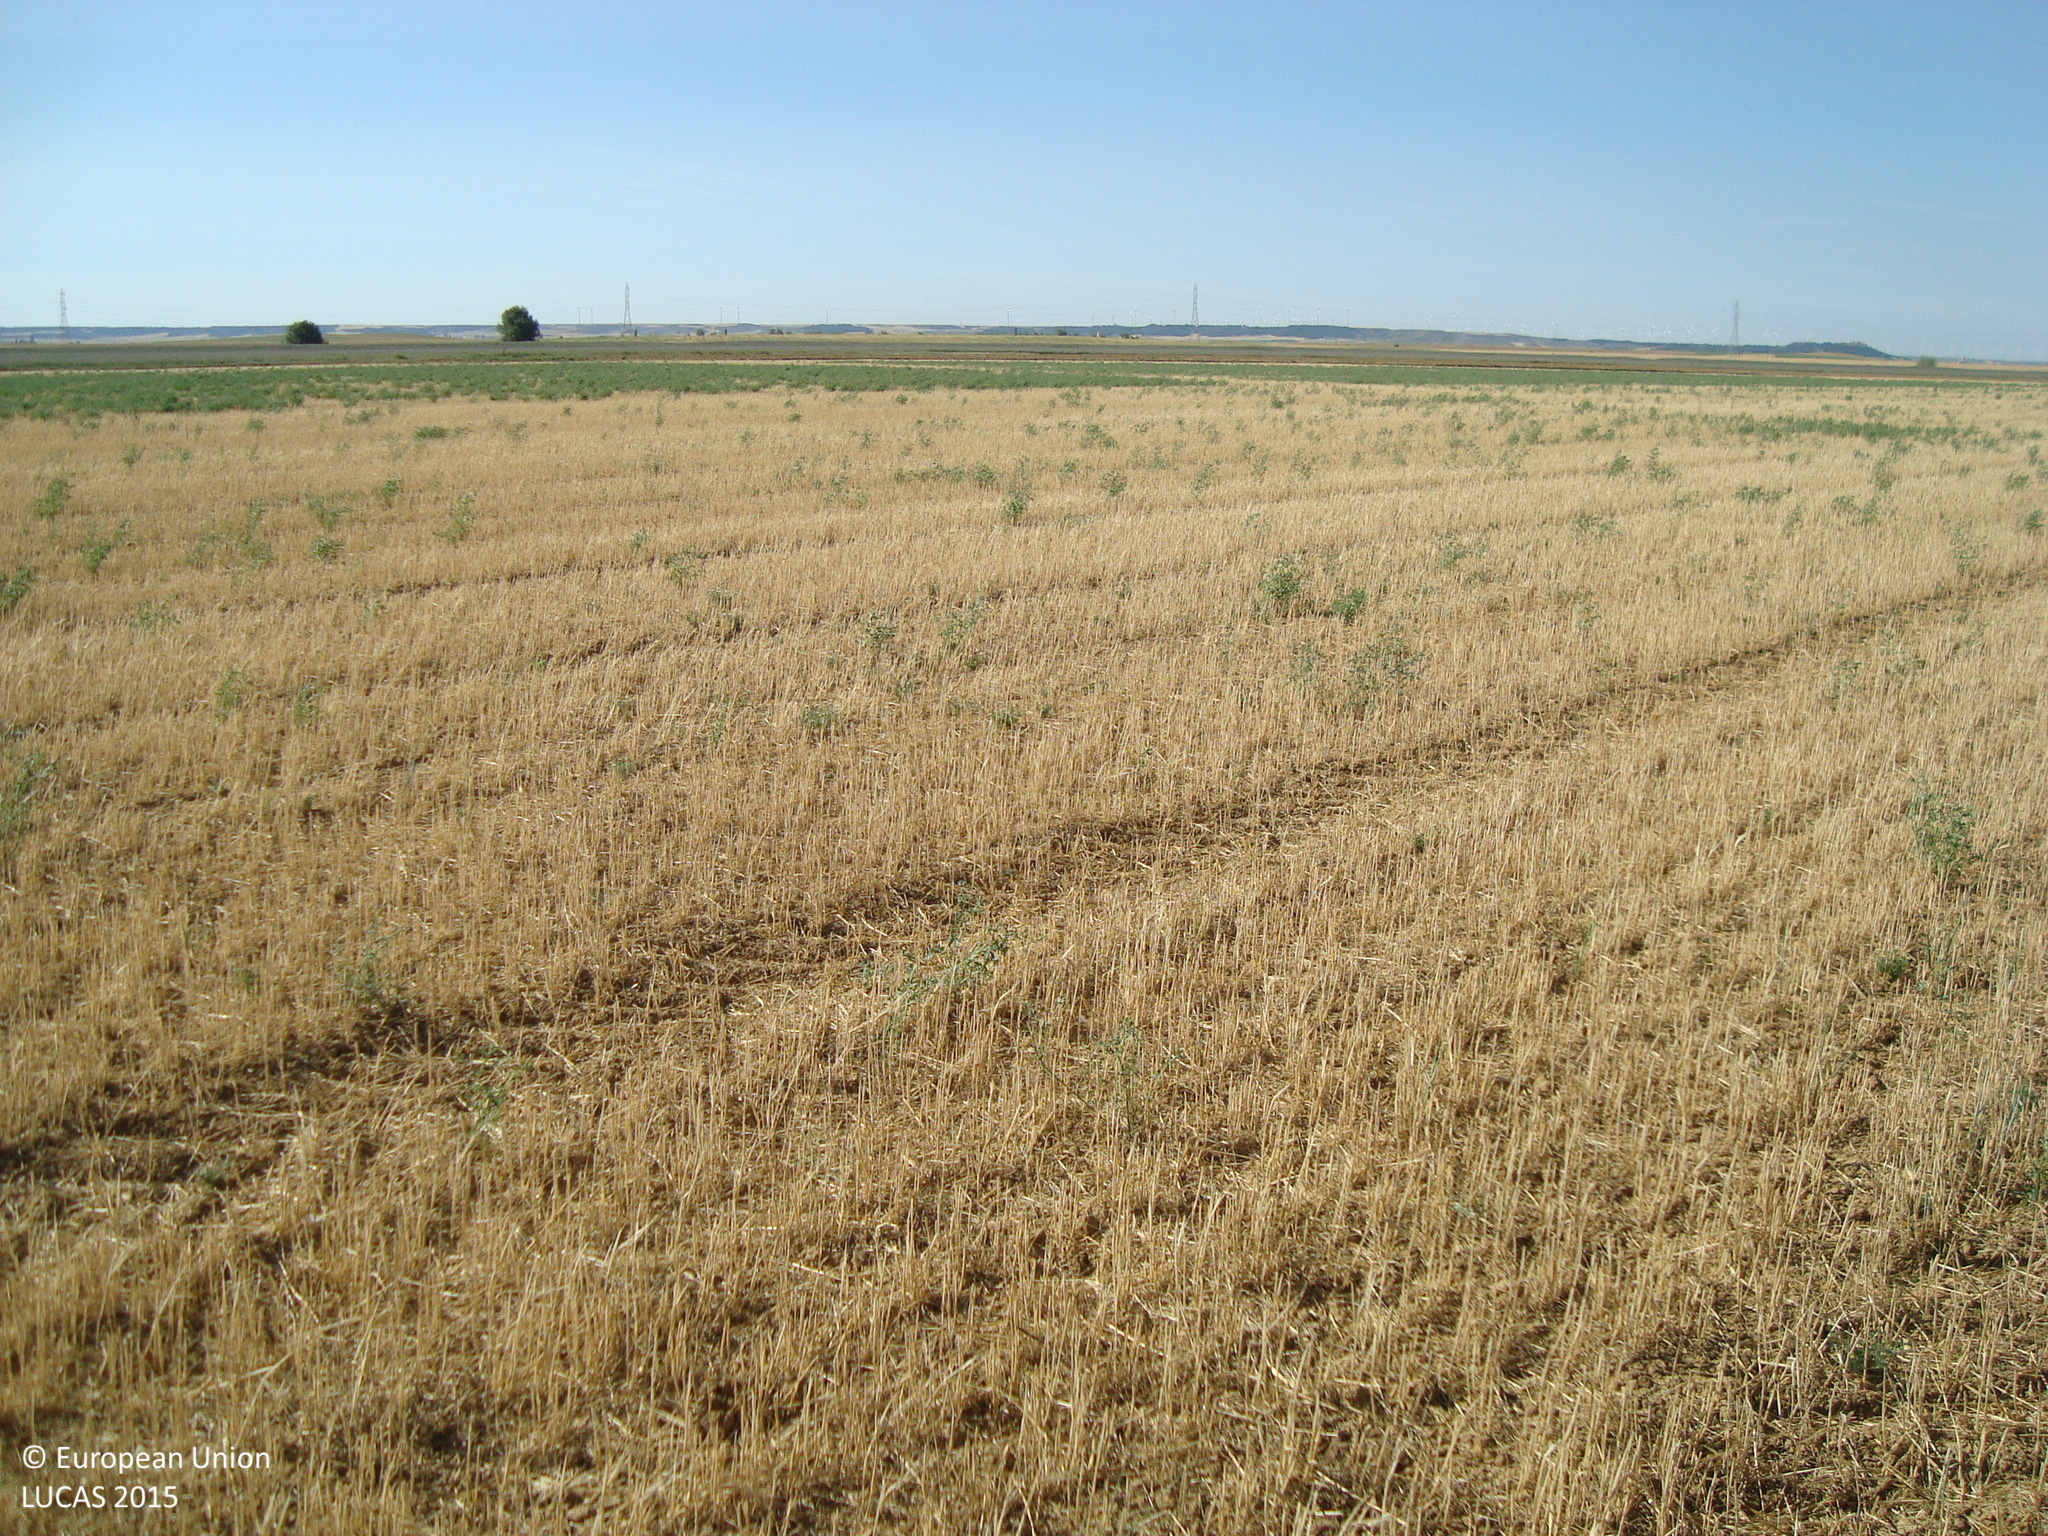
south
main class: Cropland
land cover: Barley
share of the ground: < 10 %
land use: Agriculture (excluding fallow land and kitchen gardens)
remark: Harvested field
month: July
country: ES
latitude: 42.0434
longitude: -4.7529
